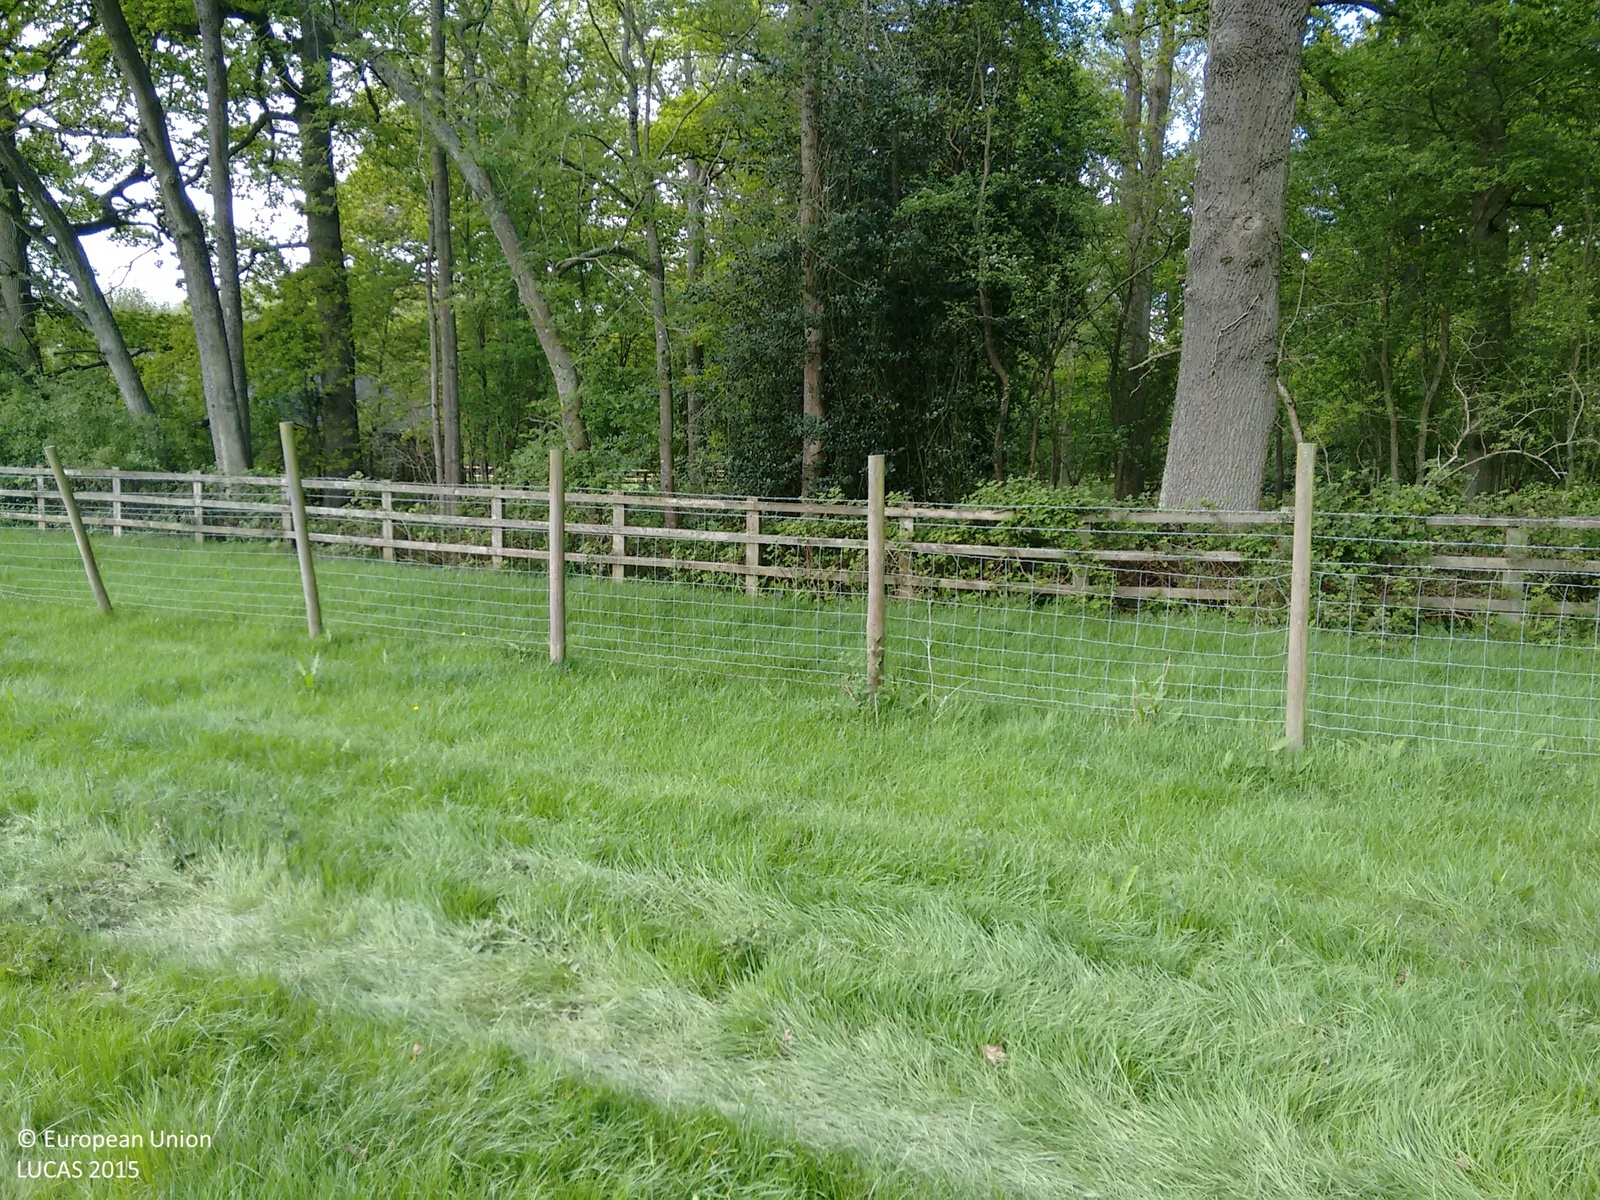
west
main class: Grassland
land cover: Grassland without tree/shrub cover
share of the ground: > 75 %
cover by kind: herbaceous plants 100 %
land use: Agriculture (excluding fallow land and kitchen gardens)
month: May
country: GB
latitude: 51.3249
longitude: -1.1392
